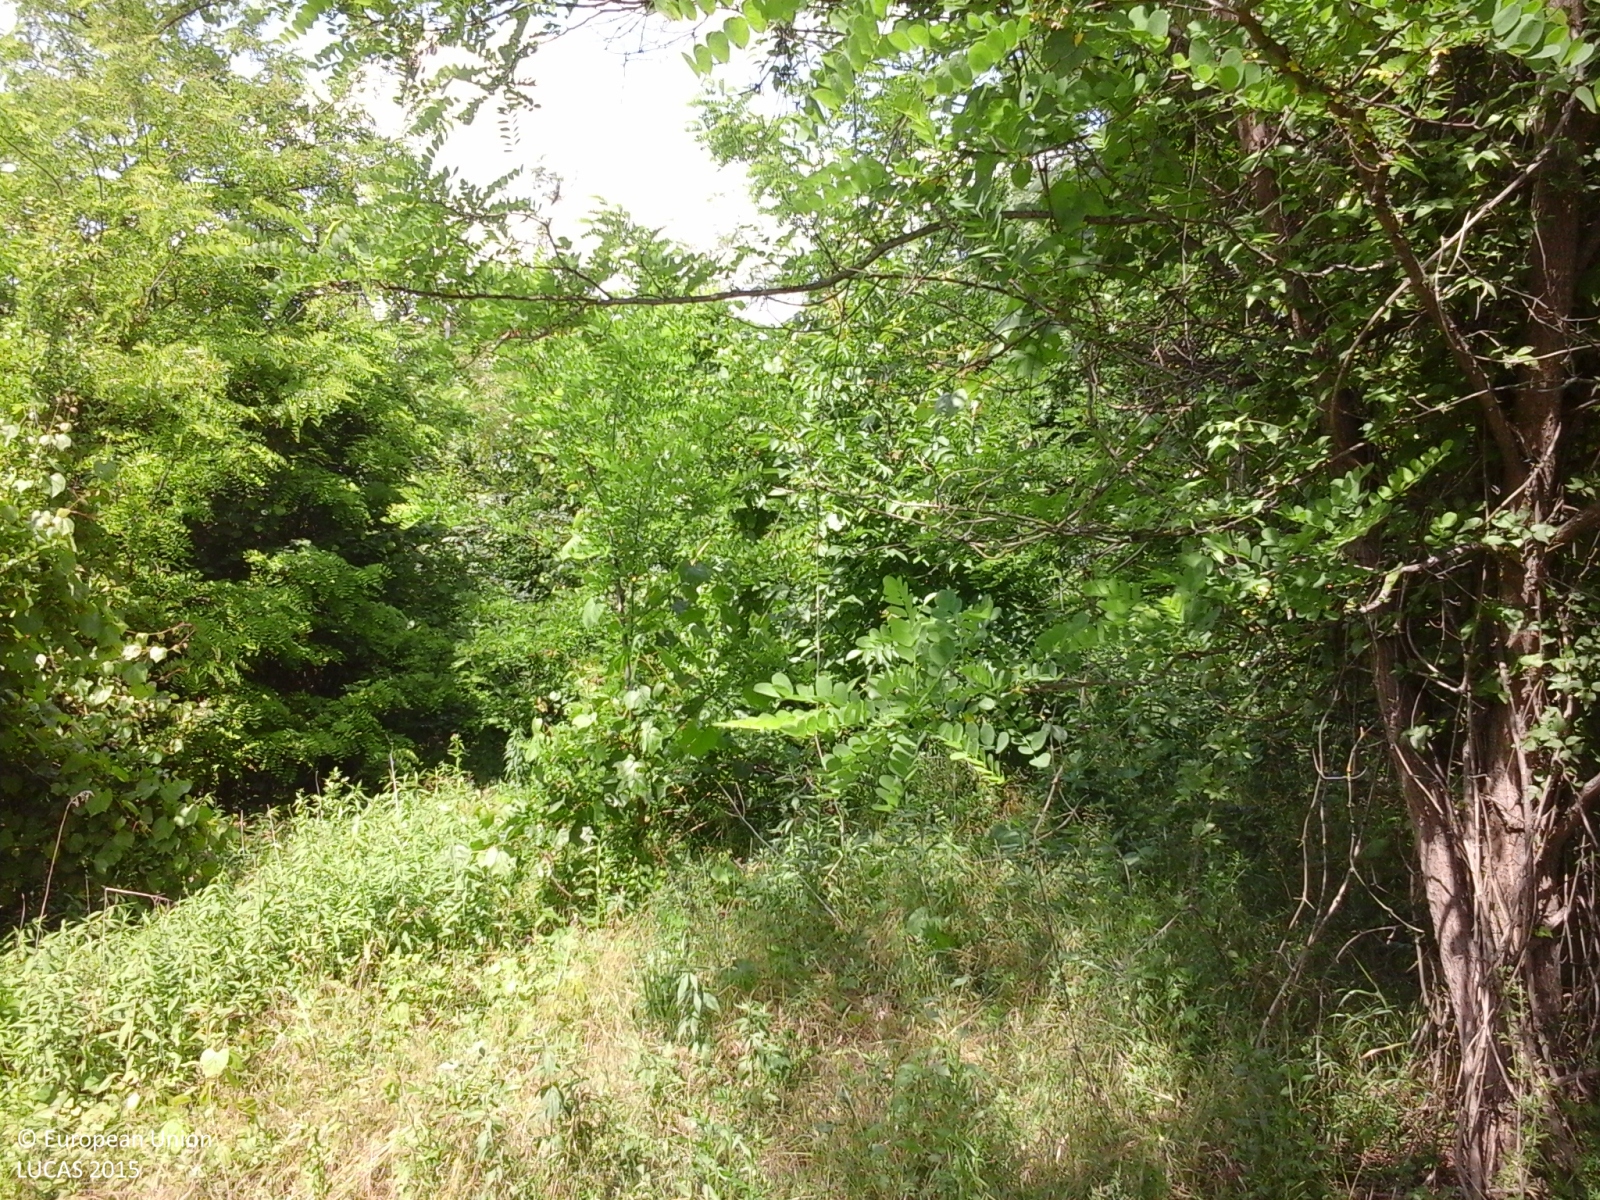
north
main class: Grassland
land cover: Grassland with sparse tree/shrub cover
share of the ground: > 75 %
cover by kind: herbaceous plants 85 %, shrubs 10 %, broadleaved forest trees 5 %
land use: Agriculture (excluding fallow land and kitchen gardens)
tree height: > 5 m
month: May
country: IT
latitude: 44.6648
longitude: 8.5274
